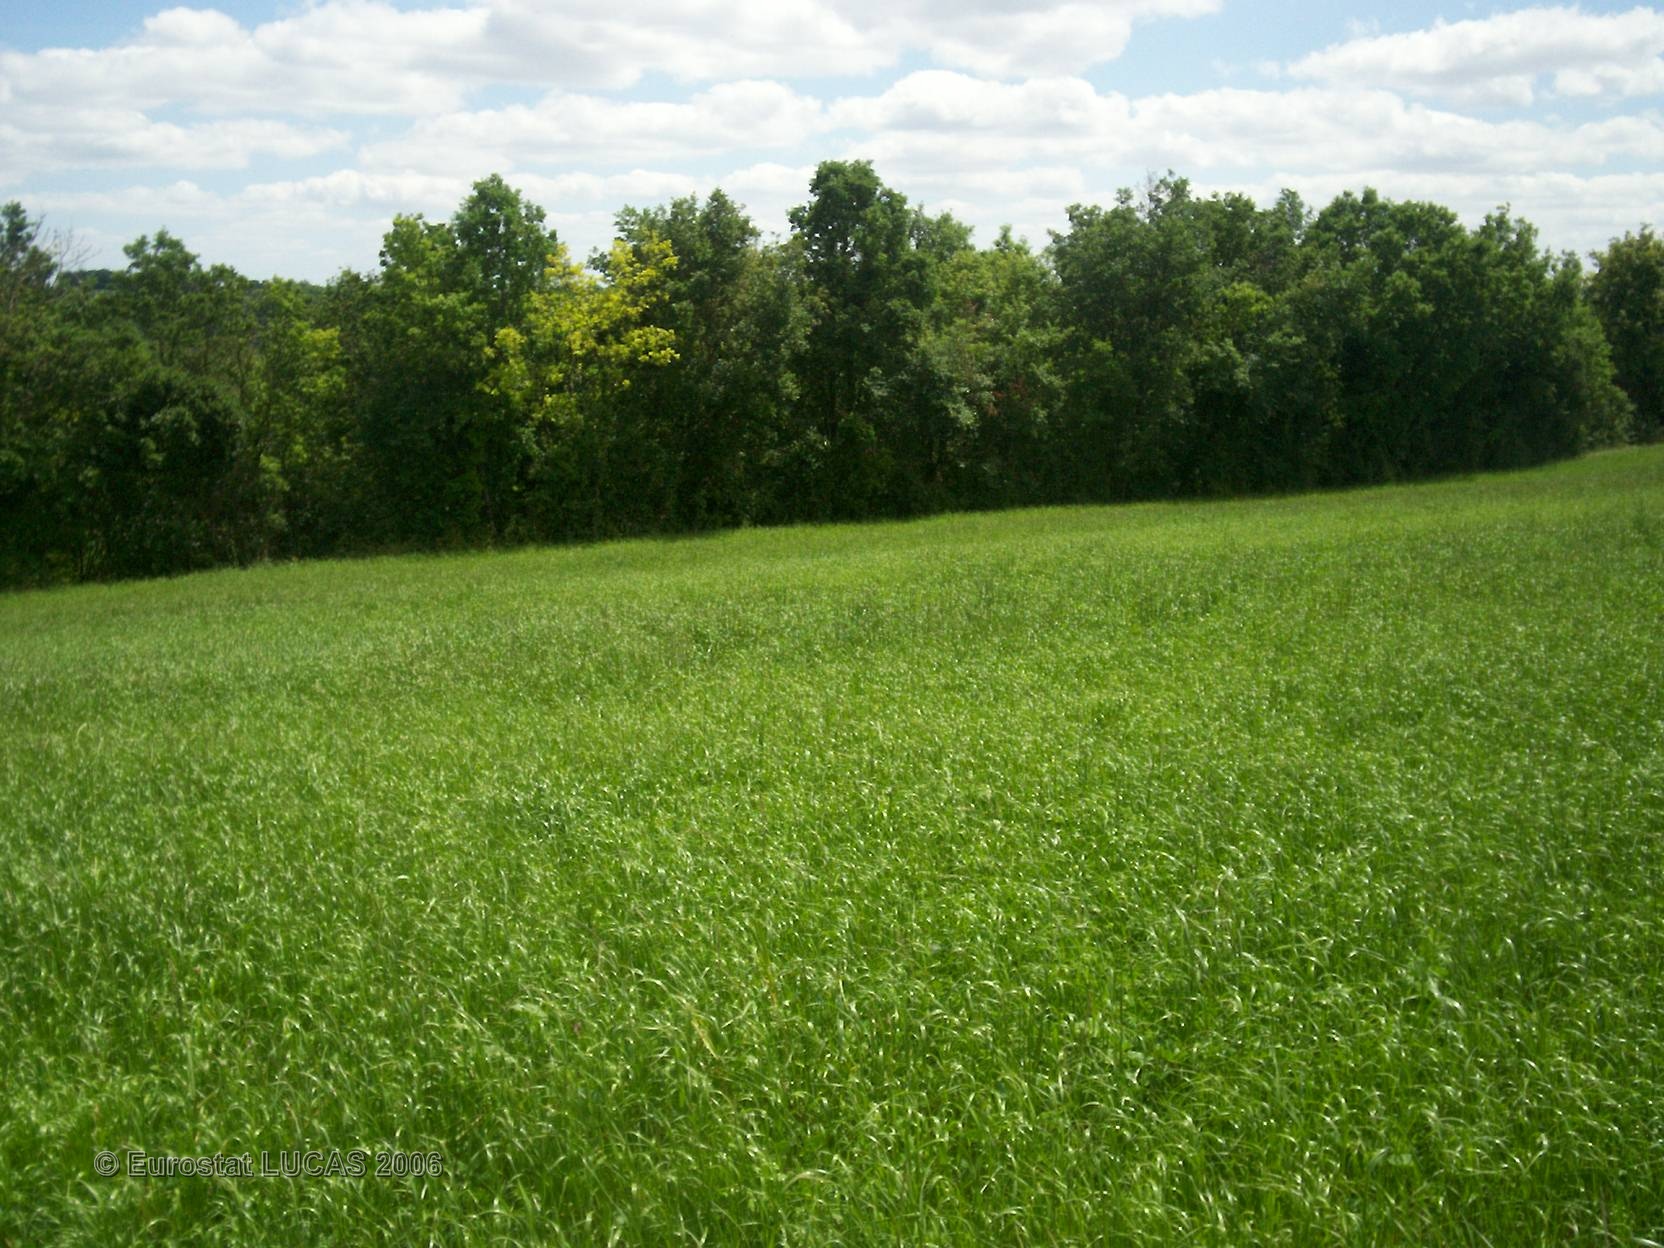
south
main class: Grassland
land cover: Grassland without tree/shrub cover
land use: Agriculture (excluding fallow land and kitchen gardens)
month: May
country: FR
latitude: 44.2801
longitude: 0.7353
